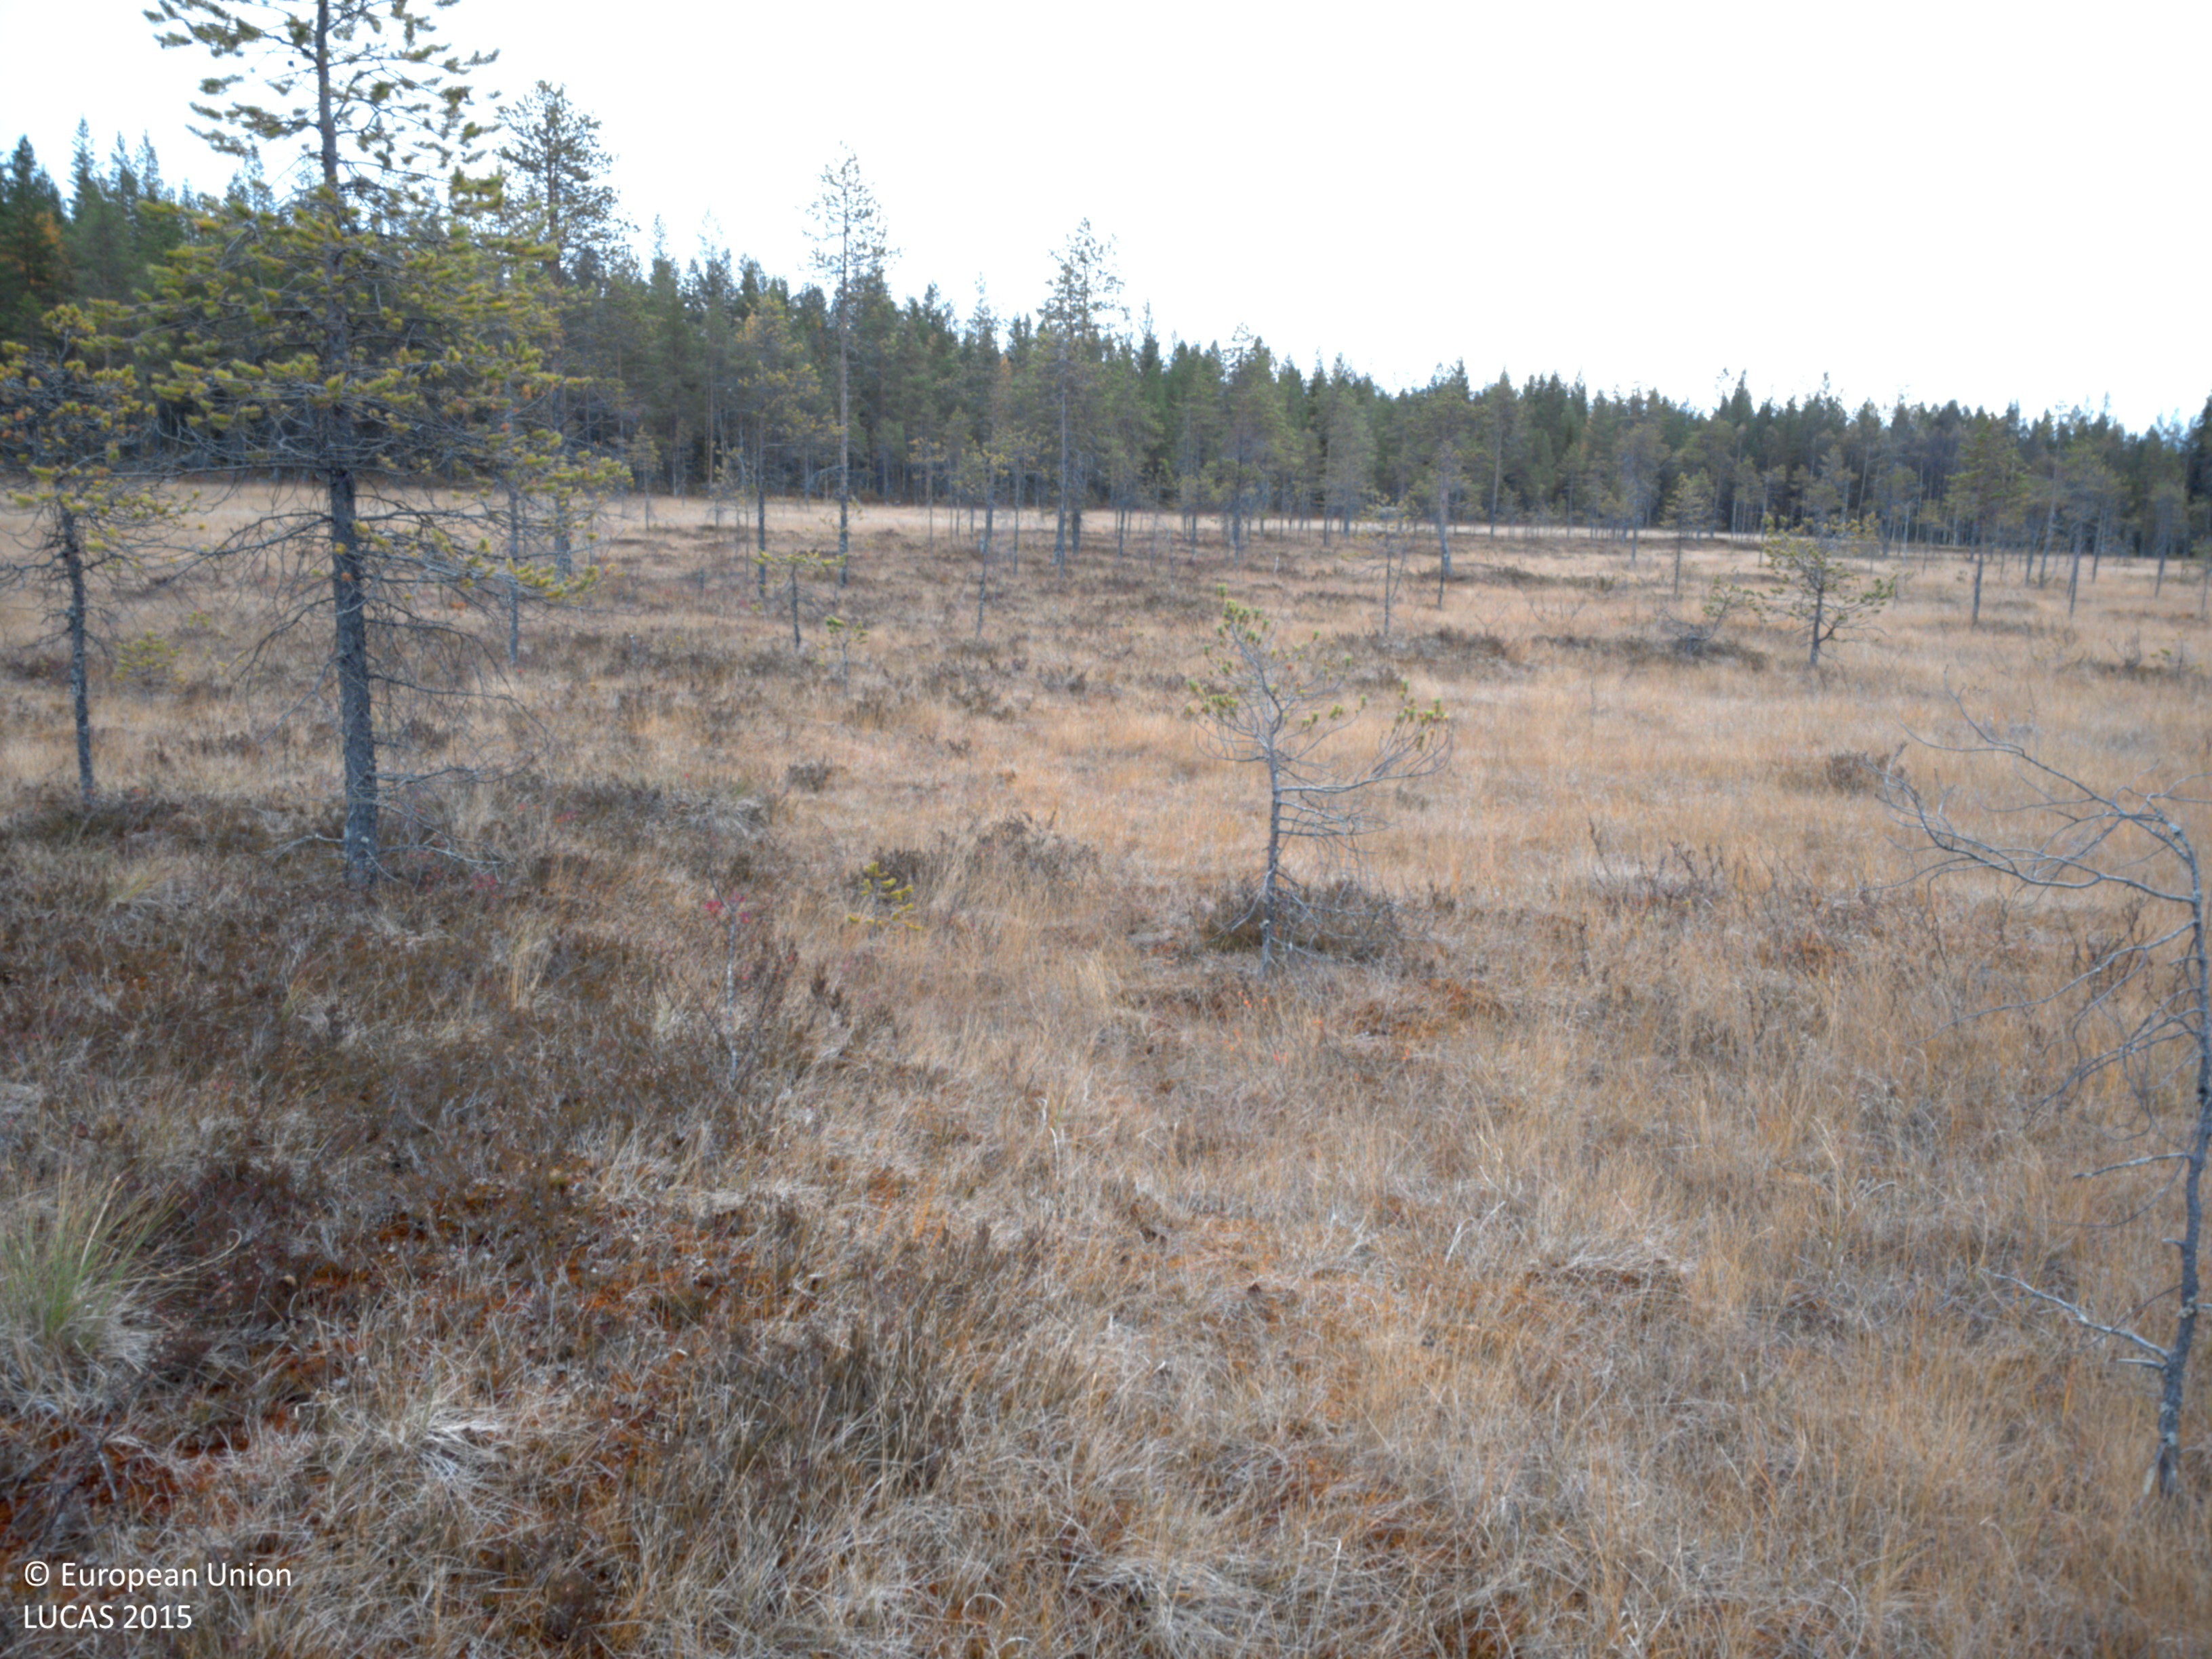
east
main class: Woodland
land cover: Pine dominated coniferous woodland
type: boreal forest
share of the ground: 10 - 25 %
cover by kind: herbaceous plants 45 %, shrubs 25 %, coniferous forest trees 15 %, lichens and mosses 15 %
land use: Semi-natural and natural areas not in use
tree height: < 5 m
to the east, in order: Pine dominated coniferous woodland; Peatbogs; Pine dominated coniferous woodland; Other coniferous woodland; Spruce dominated coniferous woodland
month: October
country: SE
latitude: 65.0211
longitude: 18.2196
